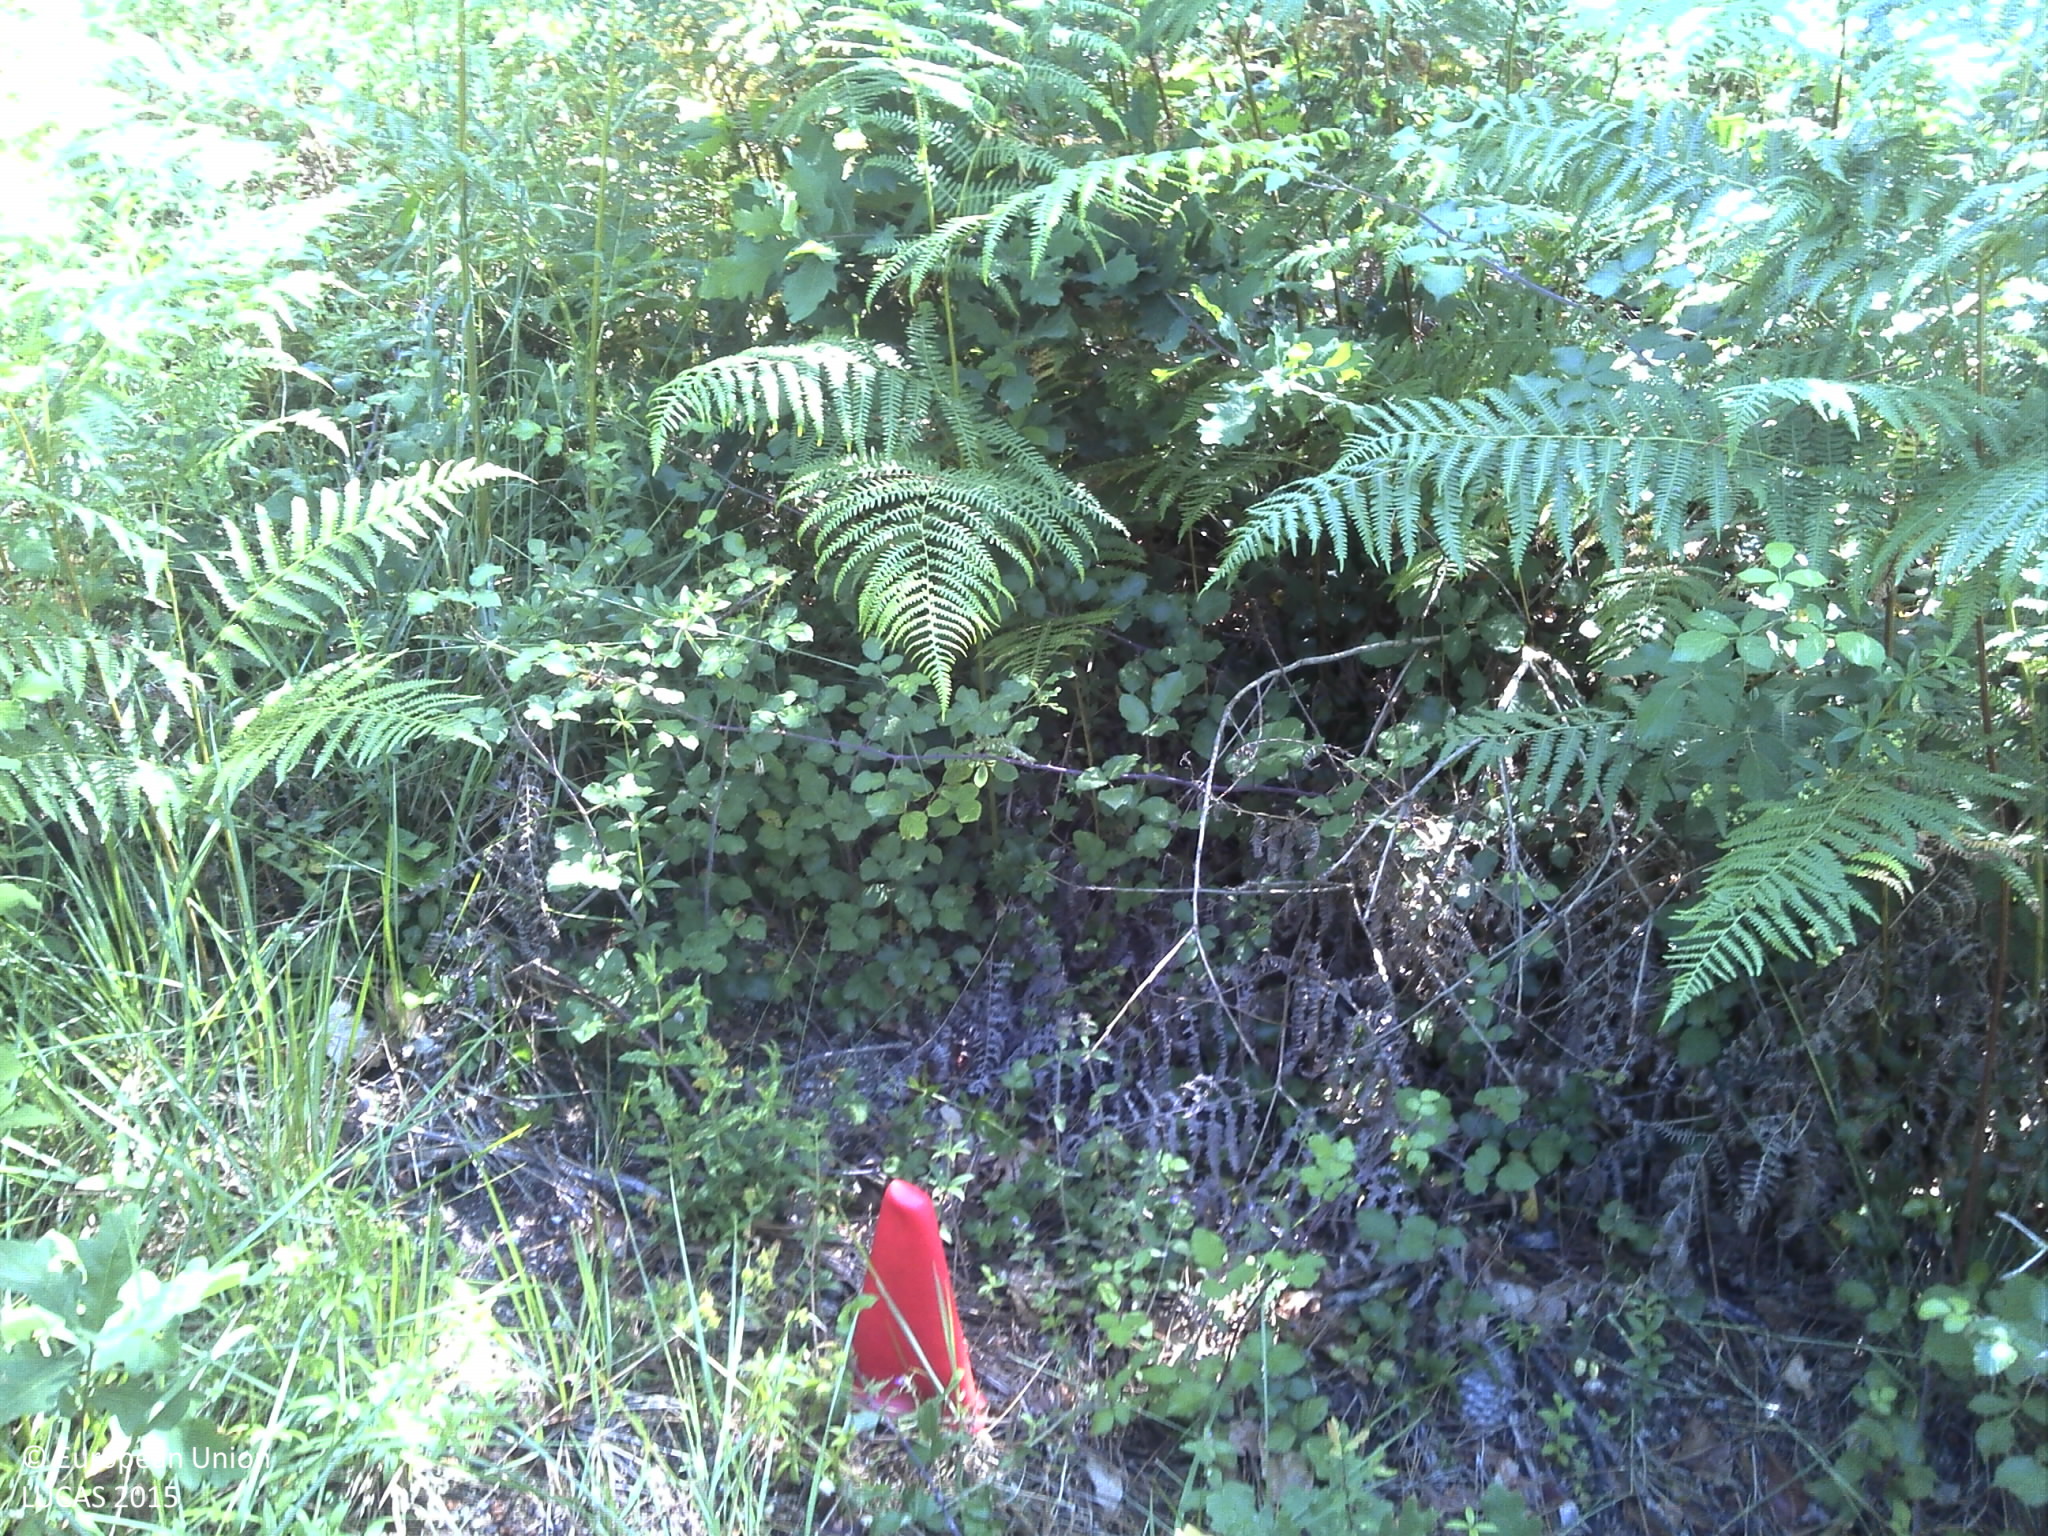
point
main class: Woodland
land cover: Pine dominated mixed woodland
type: coniferous forest of the mediterranean region
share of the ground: 25 - 50 %
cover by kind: coniferous forest trees 40 %, broadleaved forest trees 25 %, shrubs 25 %, unconsolidated bare surface 10 %
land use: Forestry
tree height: > 5 m
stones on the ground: < 10 %
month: June
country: PT
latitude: 40.8319
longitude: -8.0491
